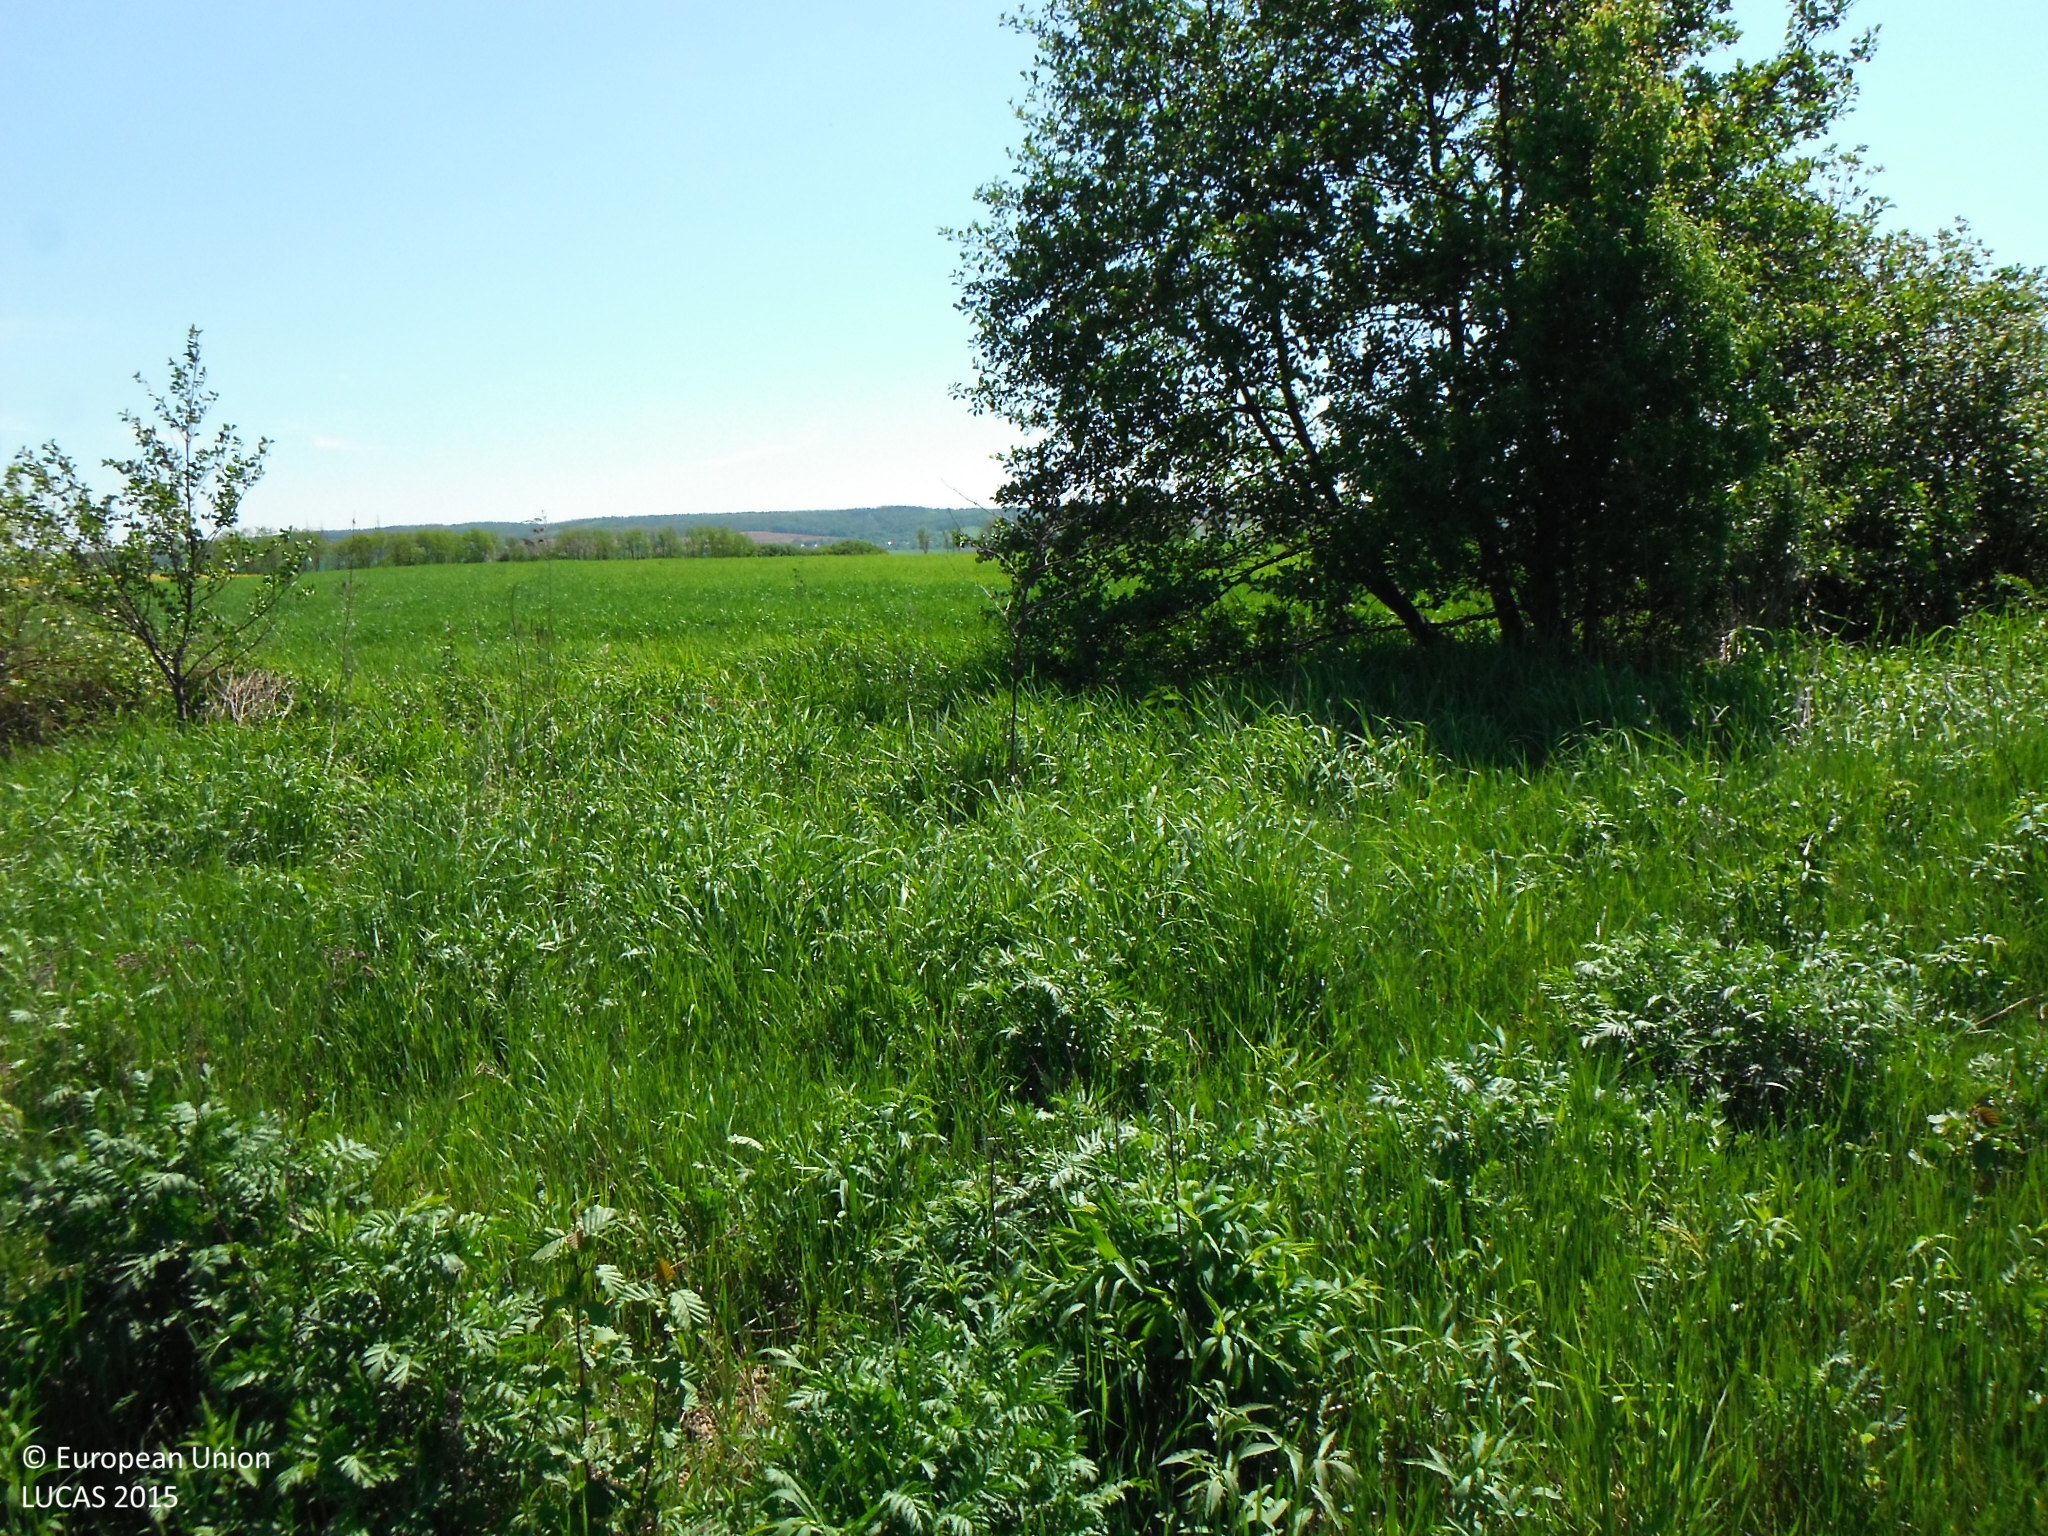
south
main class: Grassland
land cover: Spontaneously vegetated surfaces
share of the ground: > 75 %
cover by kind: herbaceous plants 100 %
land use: Fallow land
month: May
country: SK
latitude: 48.5623
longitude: 21.1677
